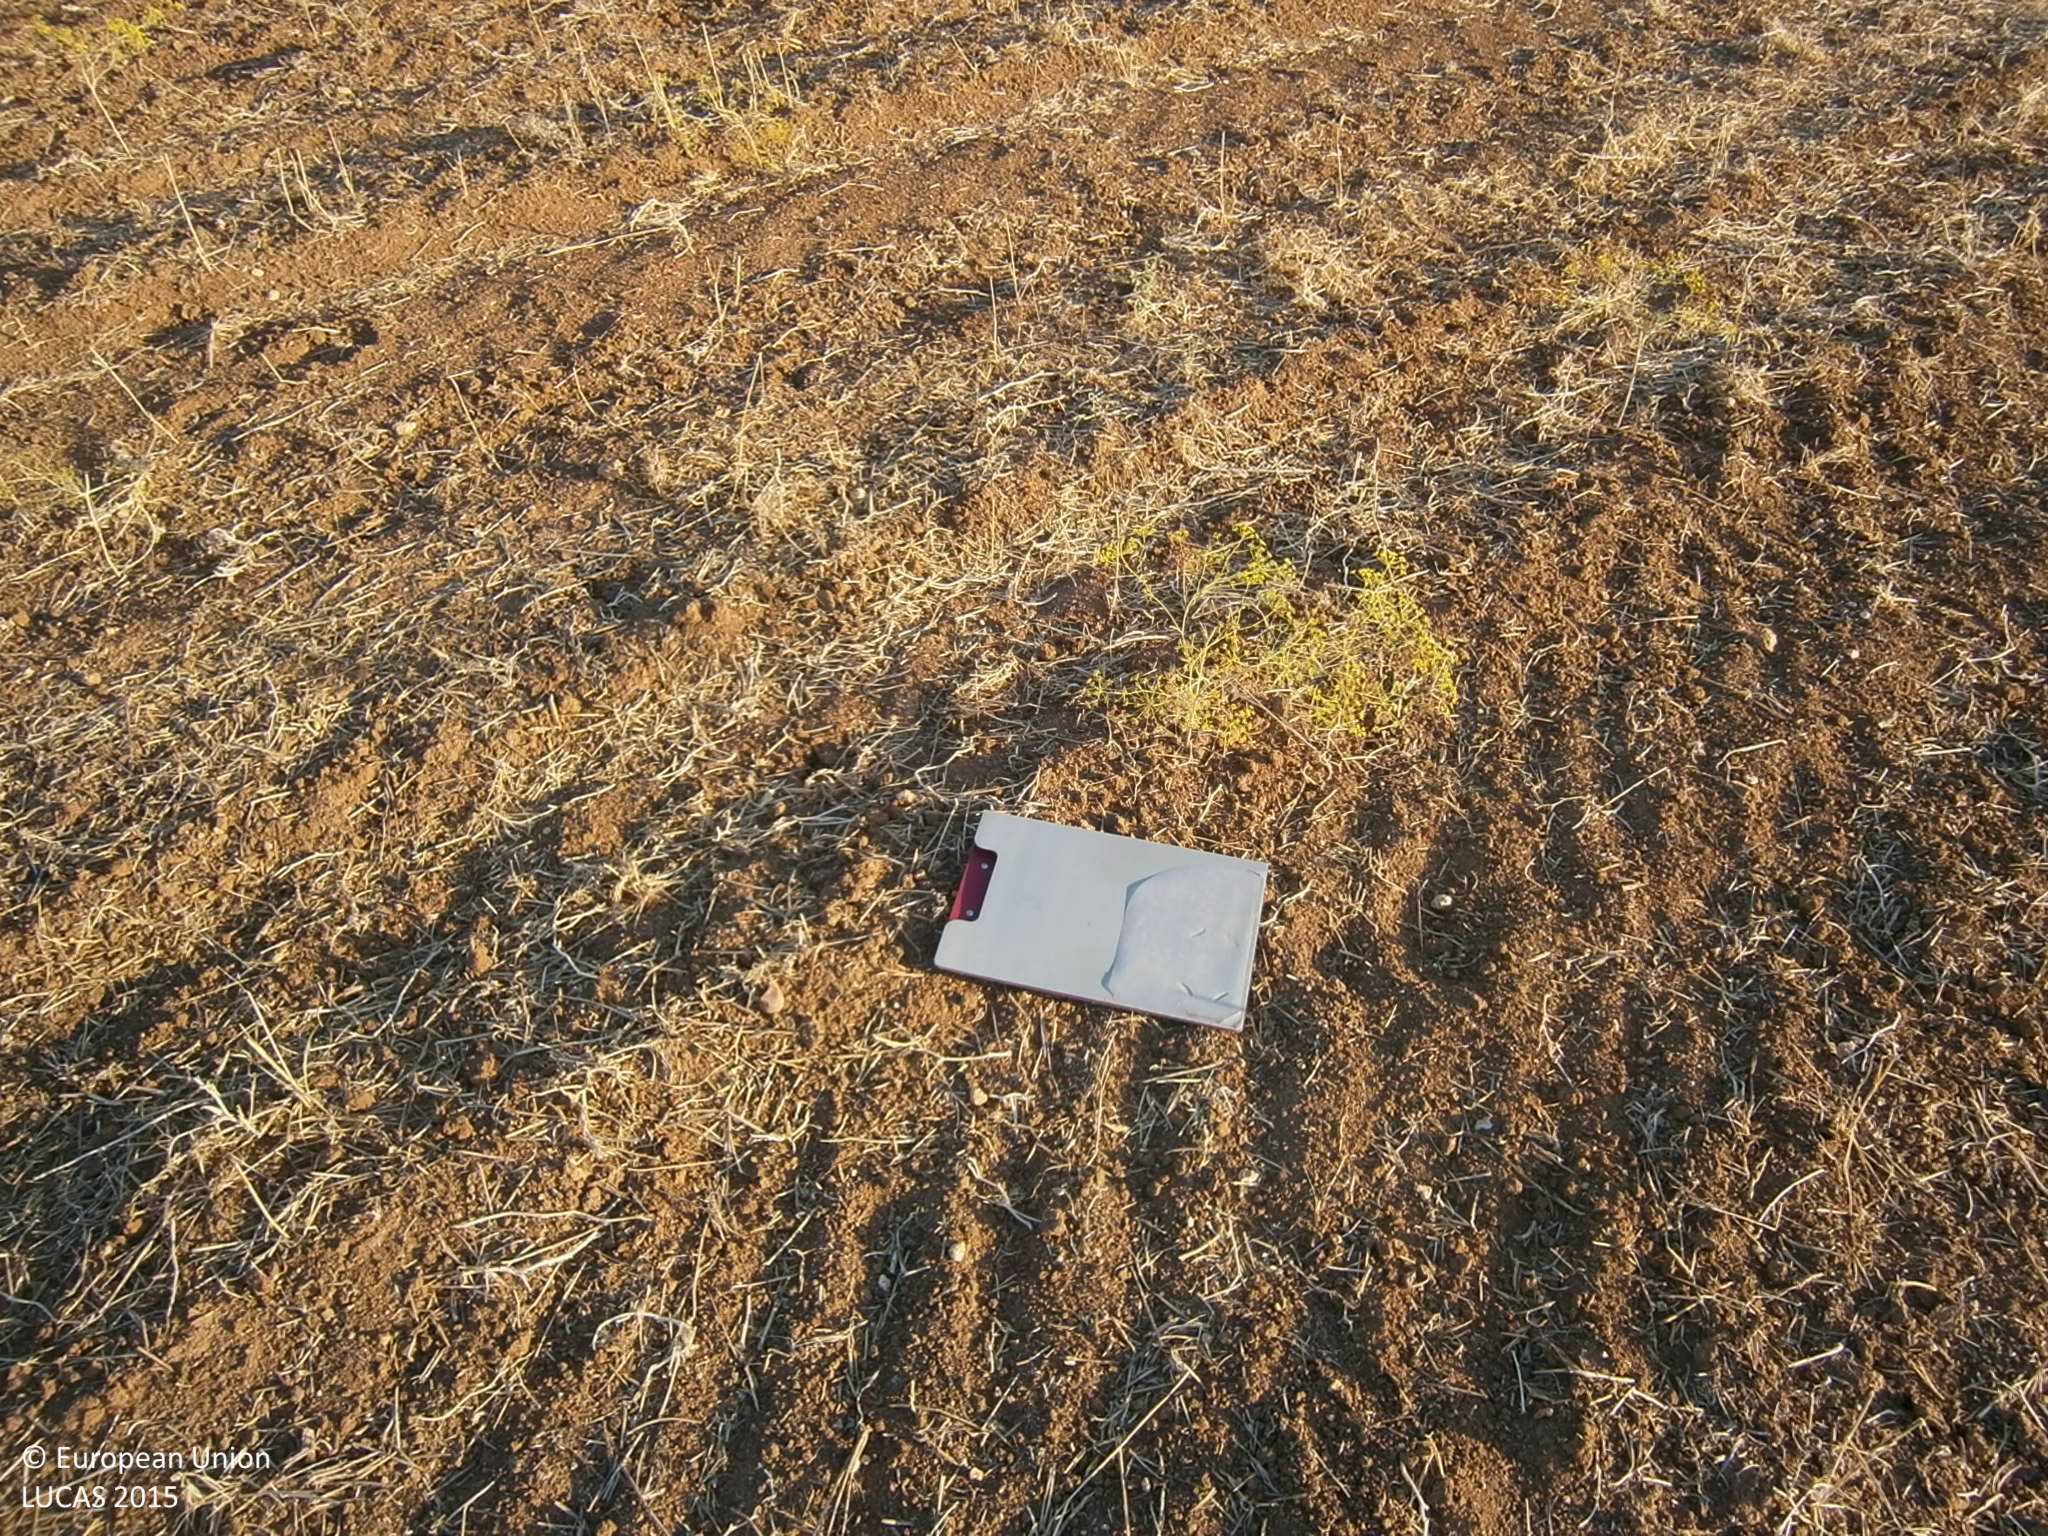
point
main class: Grassland
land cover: Spontaneously vegetated surfaces
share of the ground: 25 - 50 %
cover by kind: unconsolidated bare surface 65 %, herbaceous plants 30 %
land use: Agriculture (excluding fallow land and kitchen gardens)
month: June
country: ES
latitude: 38.7739
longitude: -6.8824
